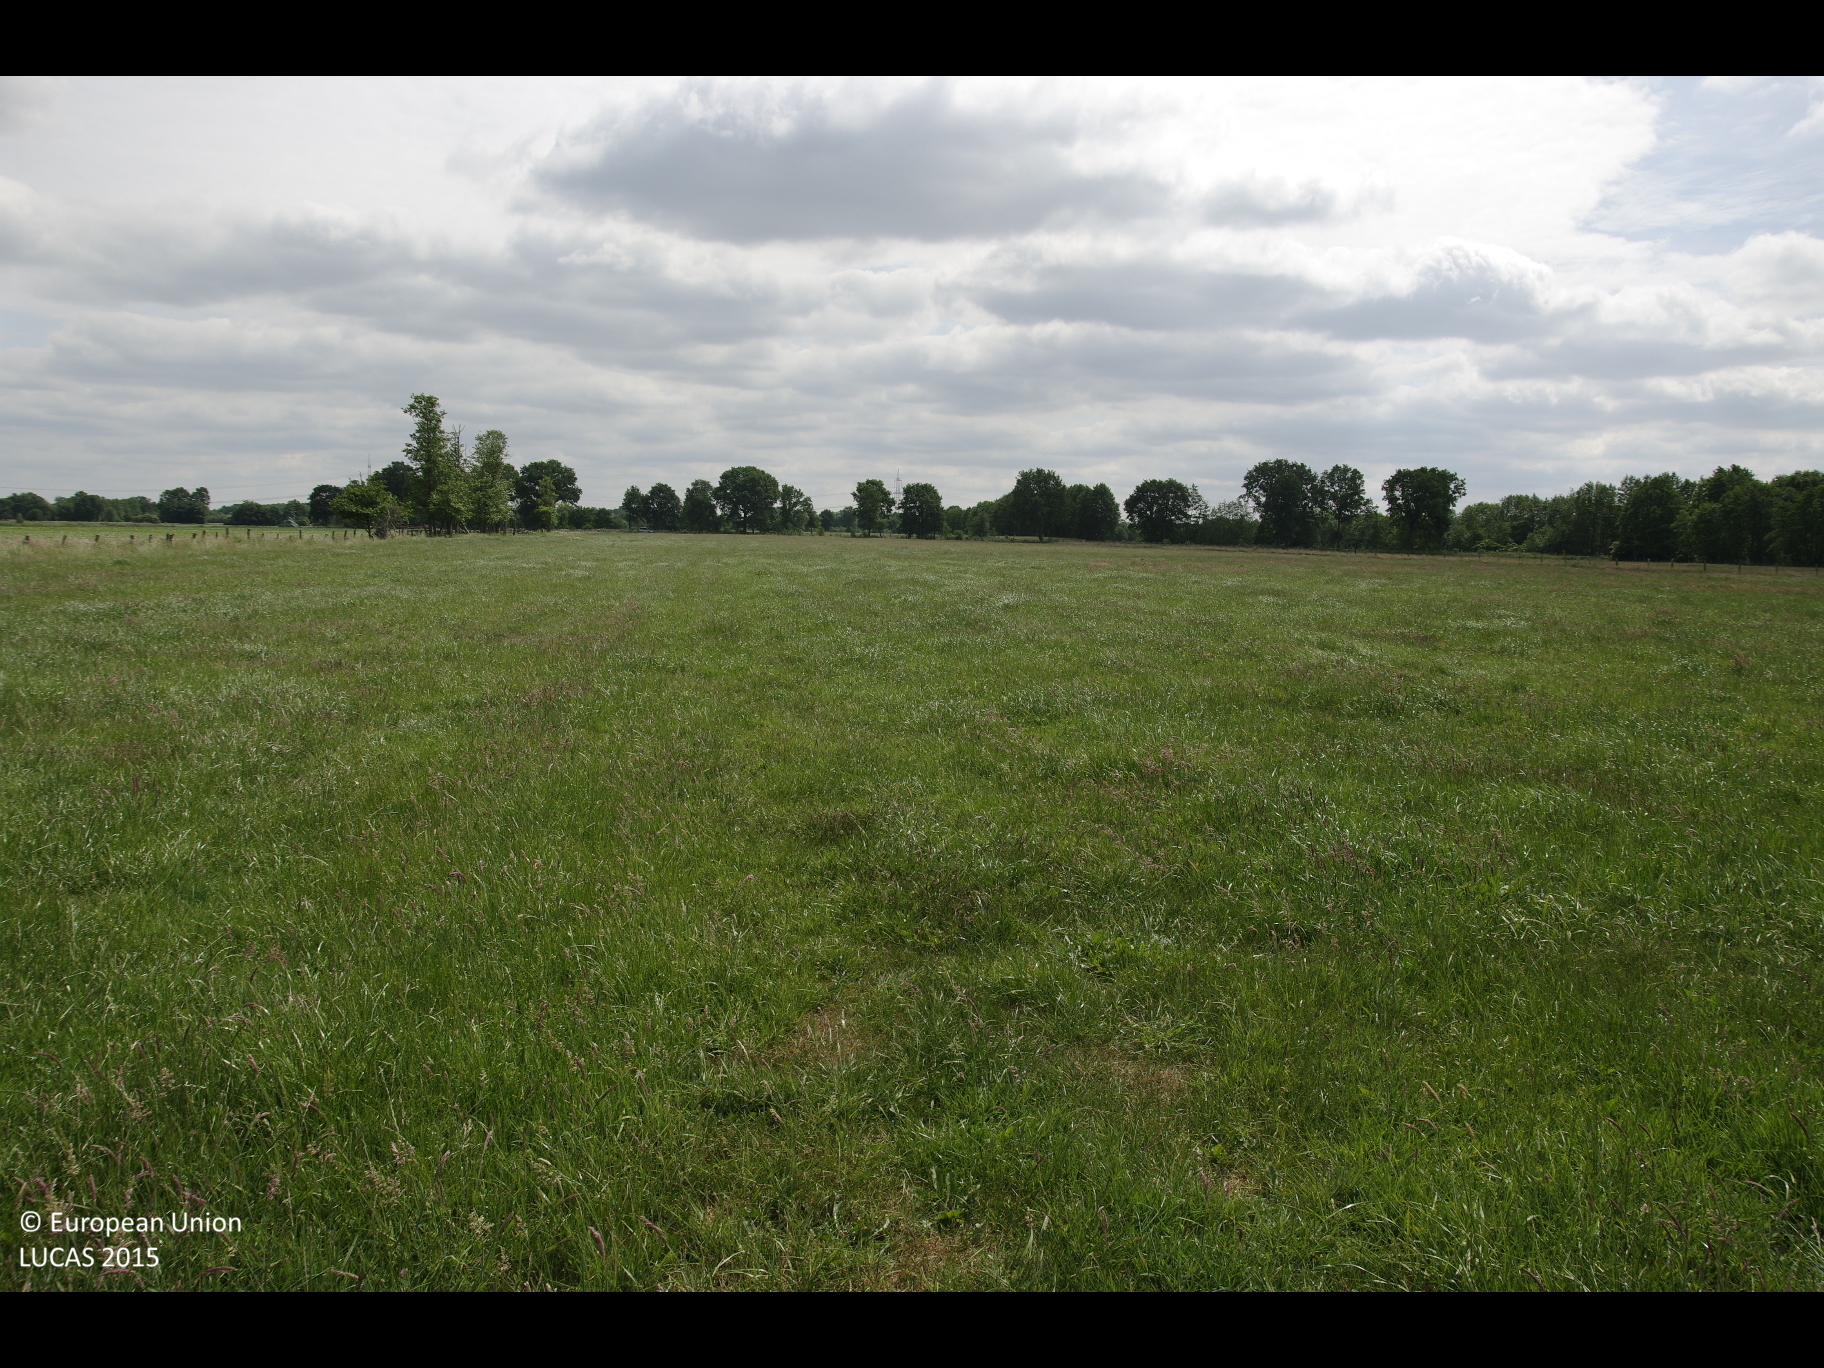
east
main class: Grassland
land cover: Grassland without tree/shrub cover
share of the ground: > 75 %
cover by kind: herbaceous plants 100 %
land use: Agriculture (excluding fallow land and kitchen gardens)
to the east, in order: Grassland without tree/shrub cover; Abandoned hedges; Fences; Grass margins; Maize
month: June
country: DE
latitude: 53.3296
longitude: 10.3152
